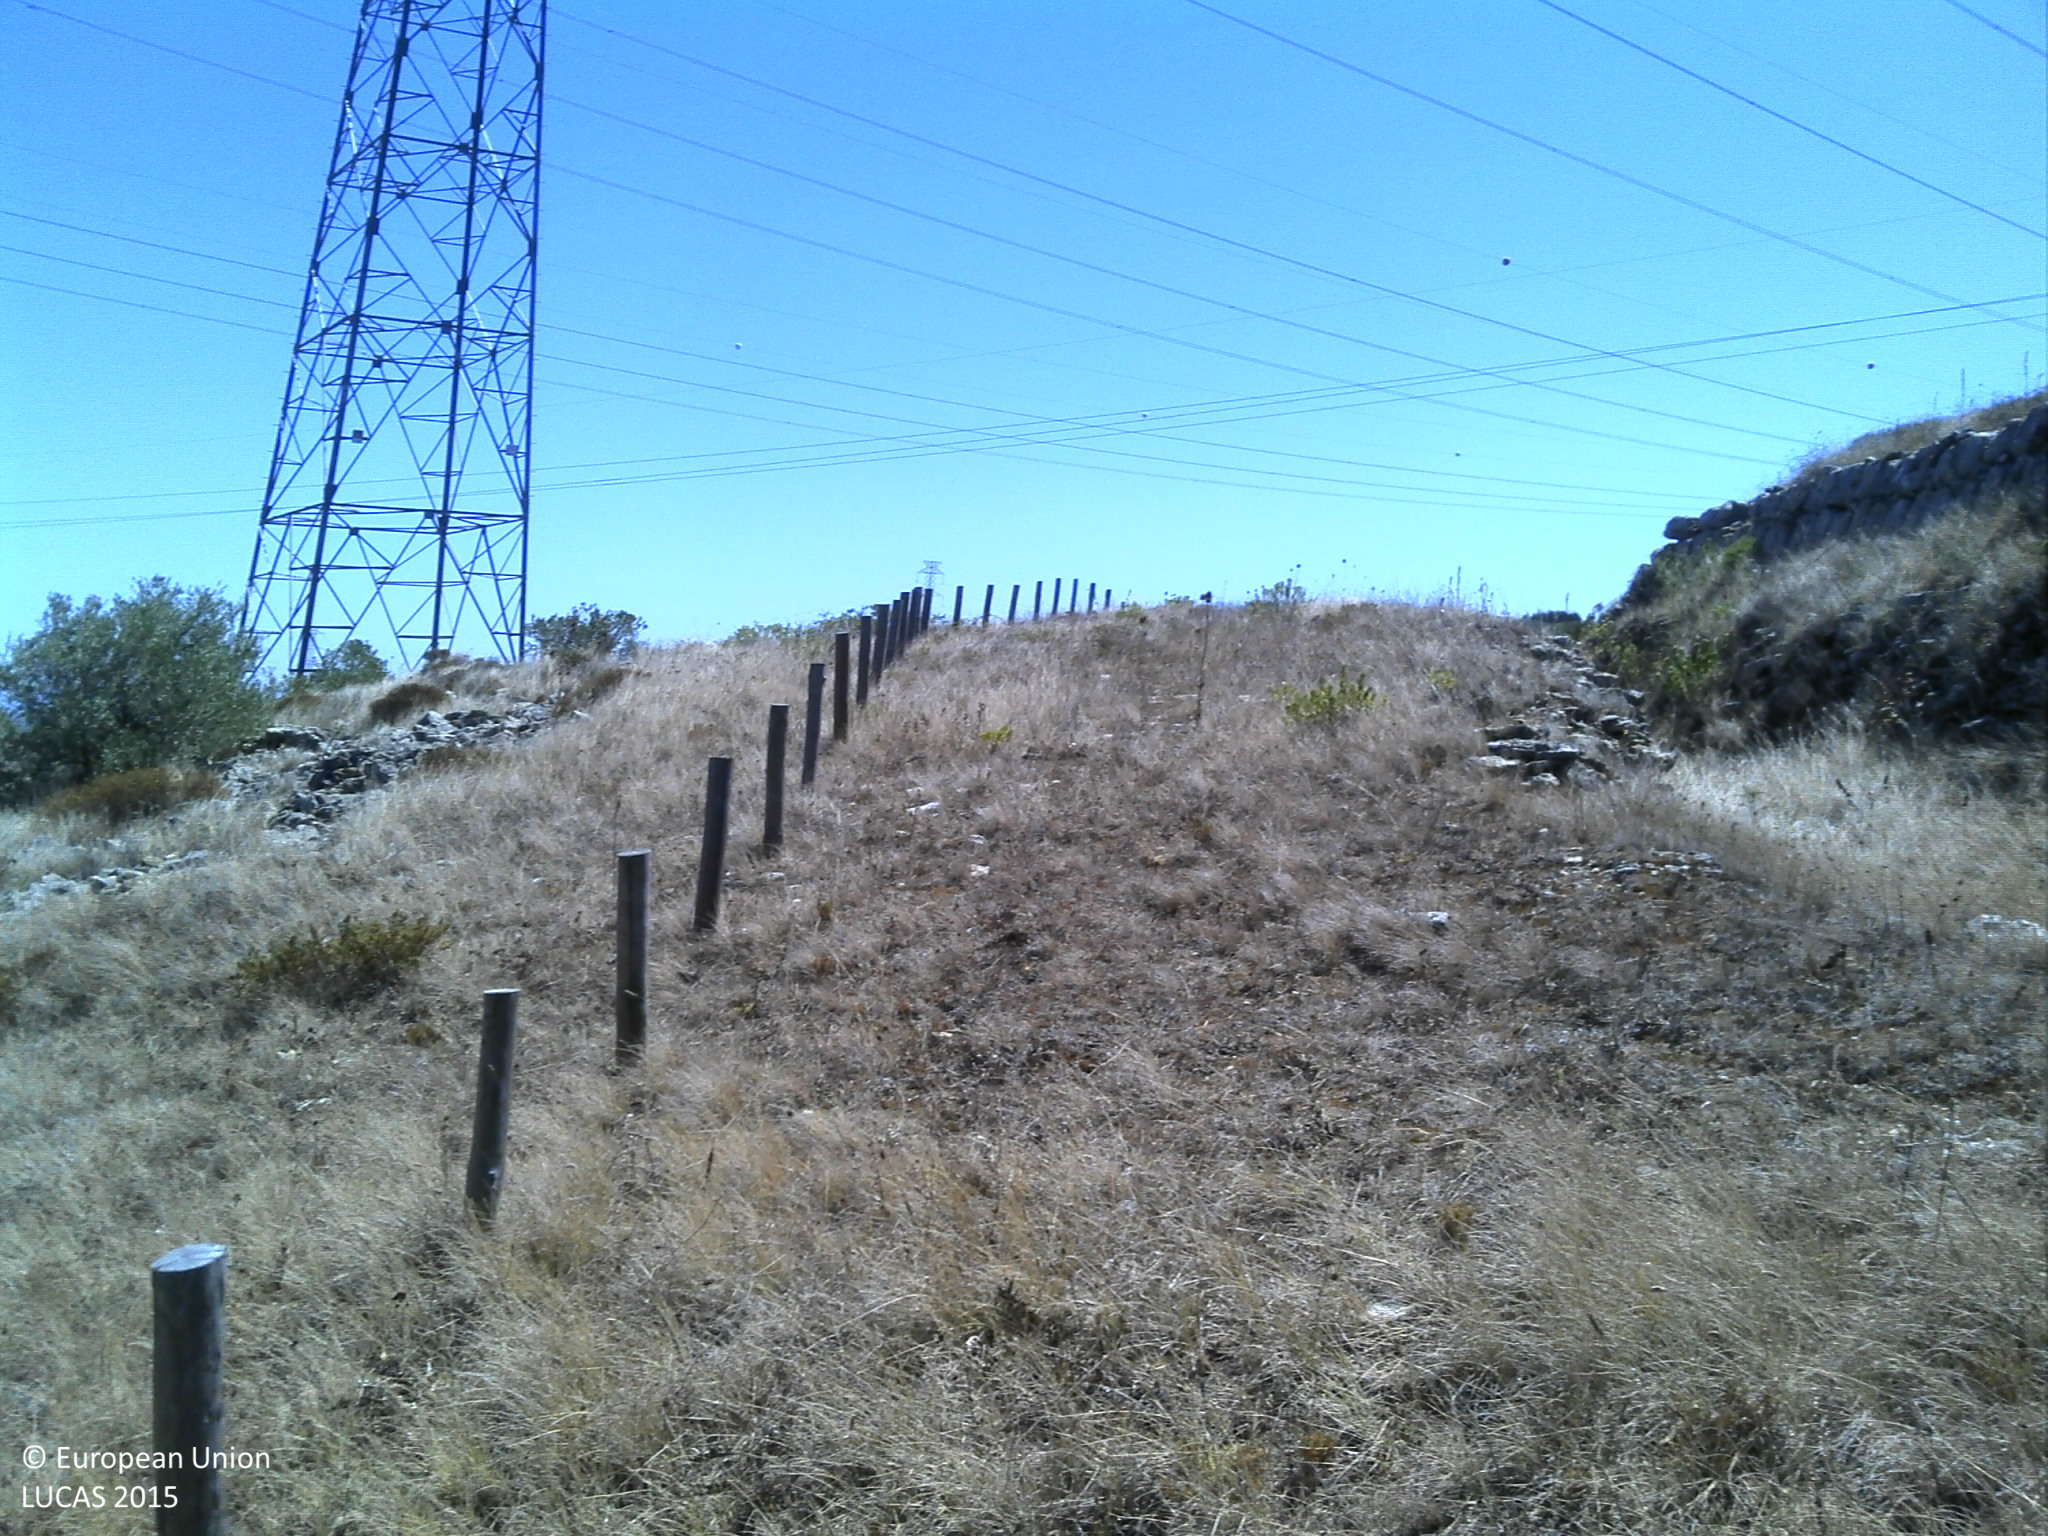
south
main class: Grassland
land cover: Grassland without tree/shrub cover
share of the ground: 50 - 75 %
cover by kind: herbaceous plants 70 %, unconsolidated bare surface 30 %
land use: Semi-natural and natural areas not in use
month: August
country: PT
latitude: 38.8961
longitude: -9.1613
